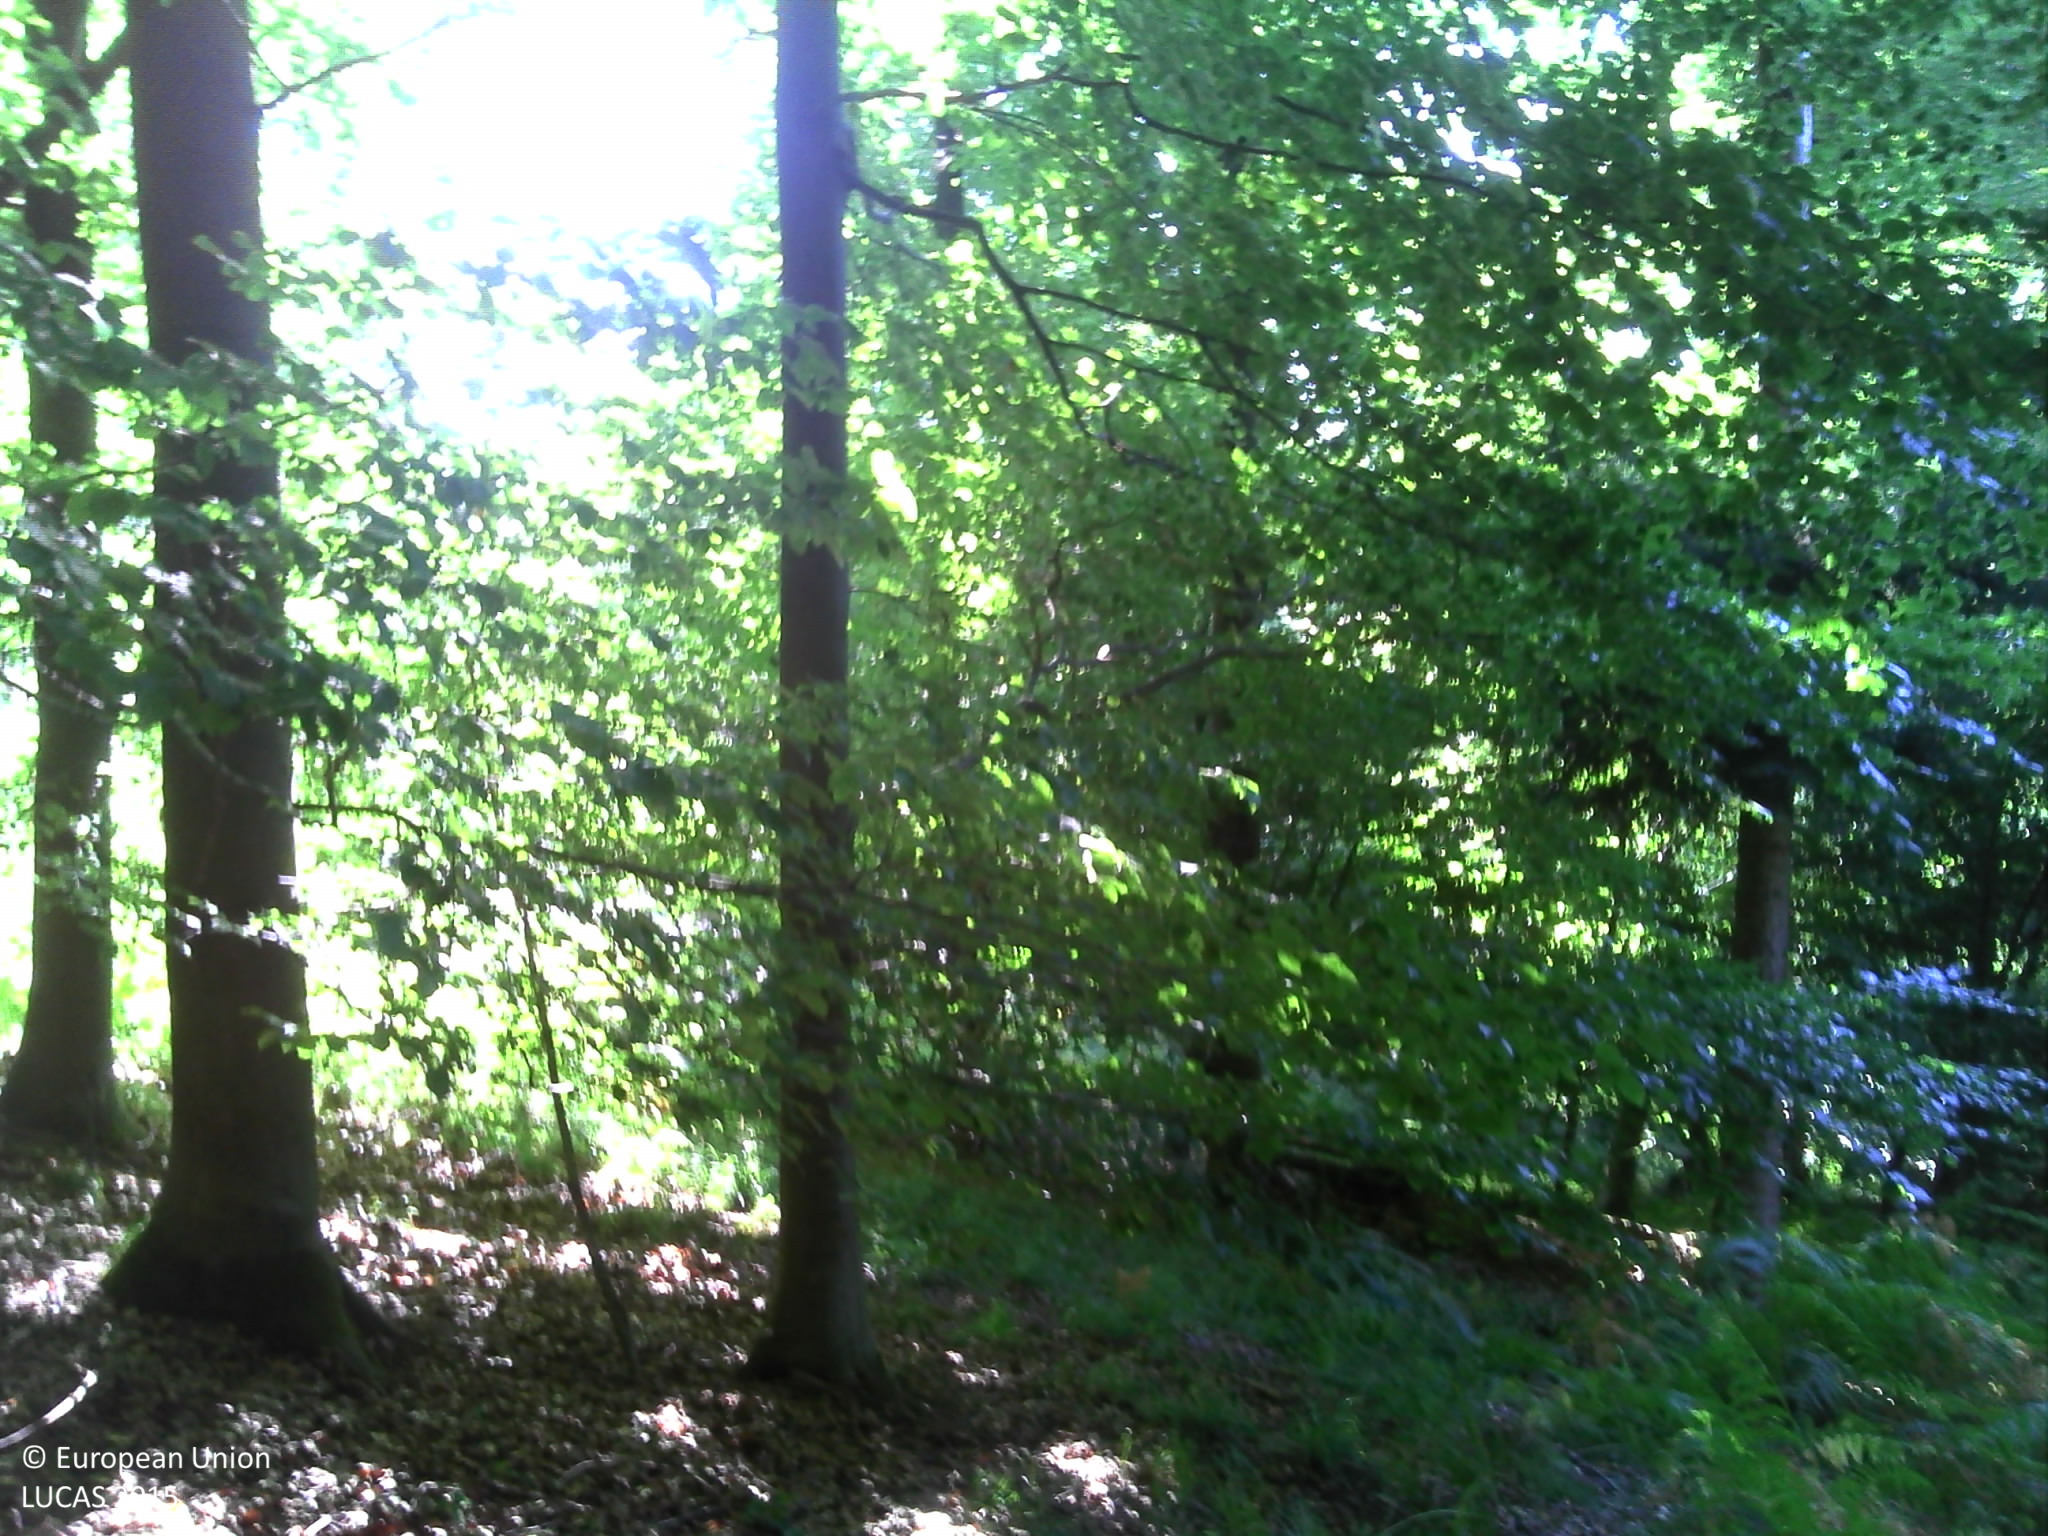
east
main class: Woodland
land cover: Broadleaved woodland
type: beech forest
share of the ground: > 75 %
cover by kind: broadleaved forest trees 95 %, coniferous forest trees 5 %
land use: Forestry
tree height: > 5 m
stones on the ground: < 10 %
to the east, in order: Broadleaved woodland; Paved roads, cycling and walking lanes; Grass margins; Broadleaved woodland
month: July
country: FR
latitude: 48.7851
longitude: 7.3194
